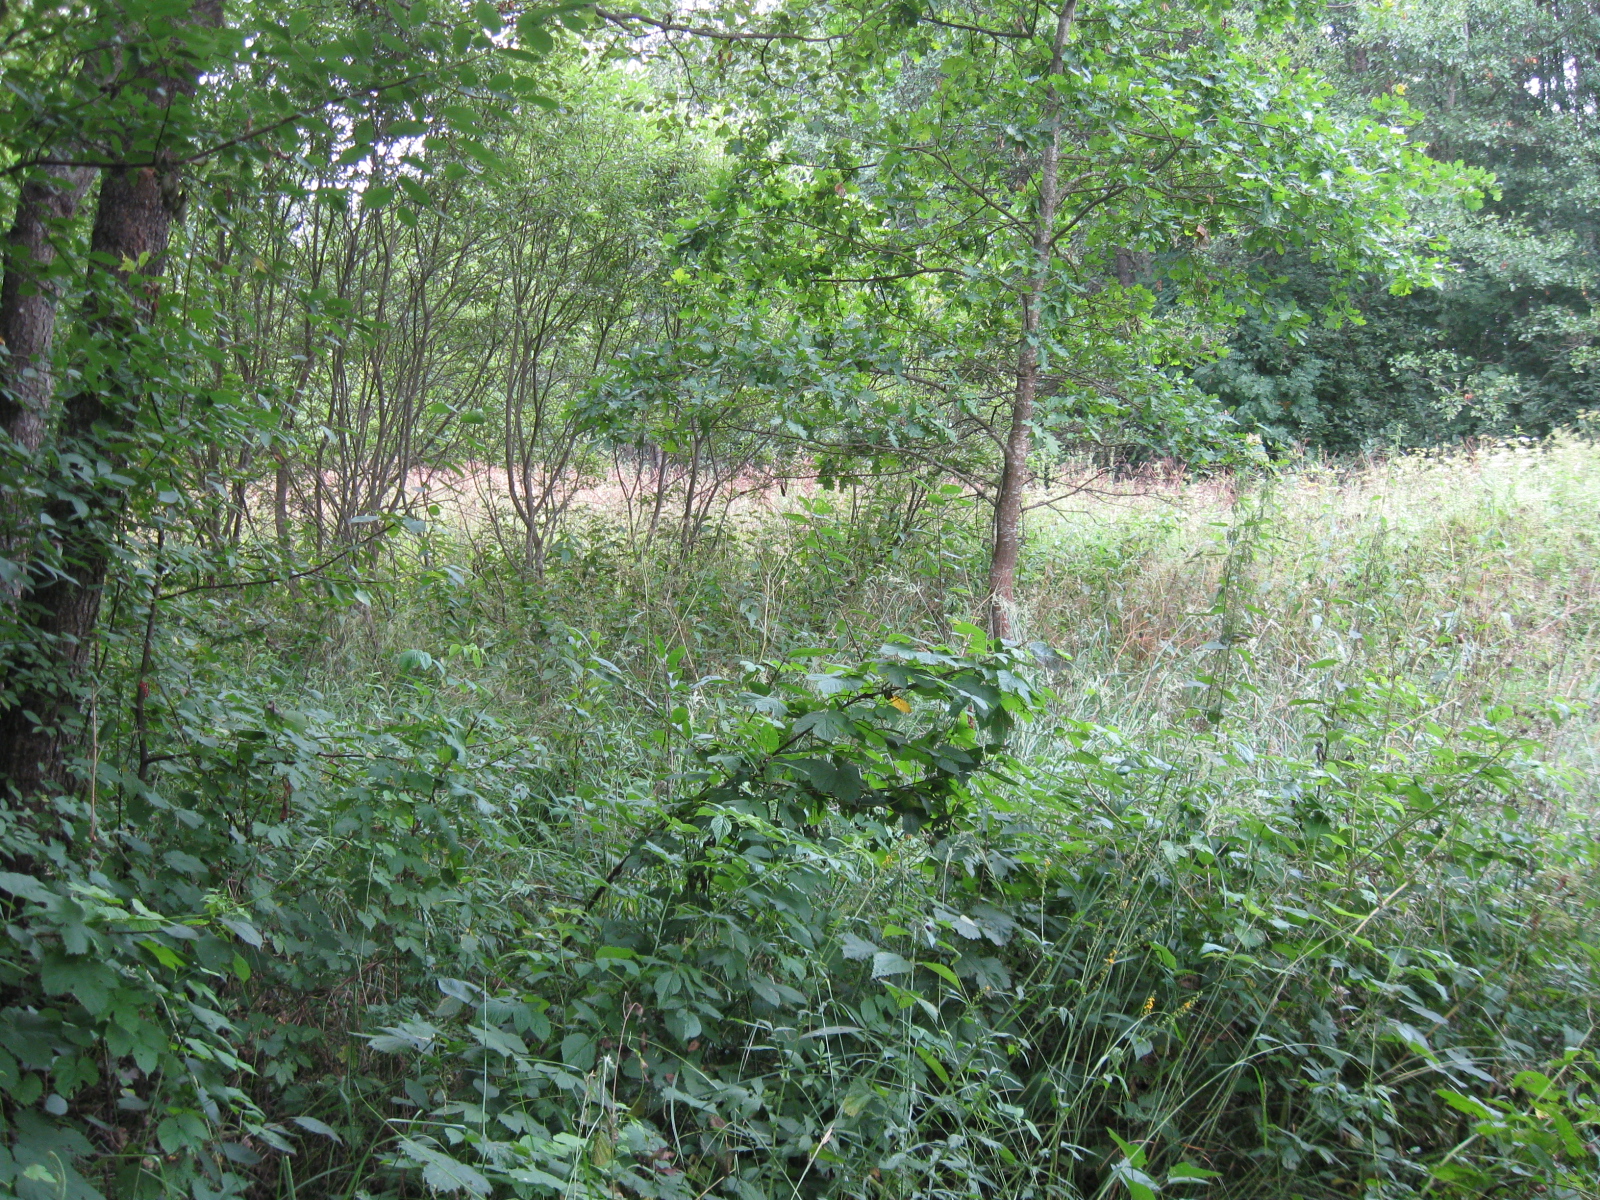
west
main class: Woodland
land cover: Broadleaved woodland
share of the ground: > 75 %
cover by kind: broadleaved forest trees 85 %, herbaceous plants 10 %, shrubs 5 %
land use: Forestry
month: July
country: LT
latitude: 54.4198
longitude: 24.3868
